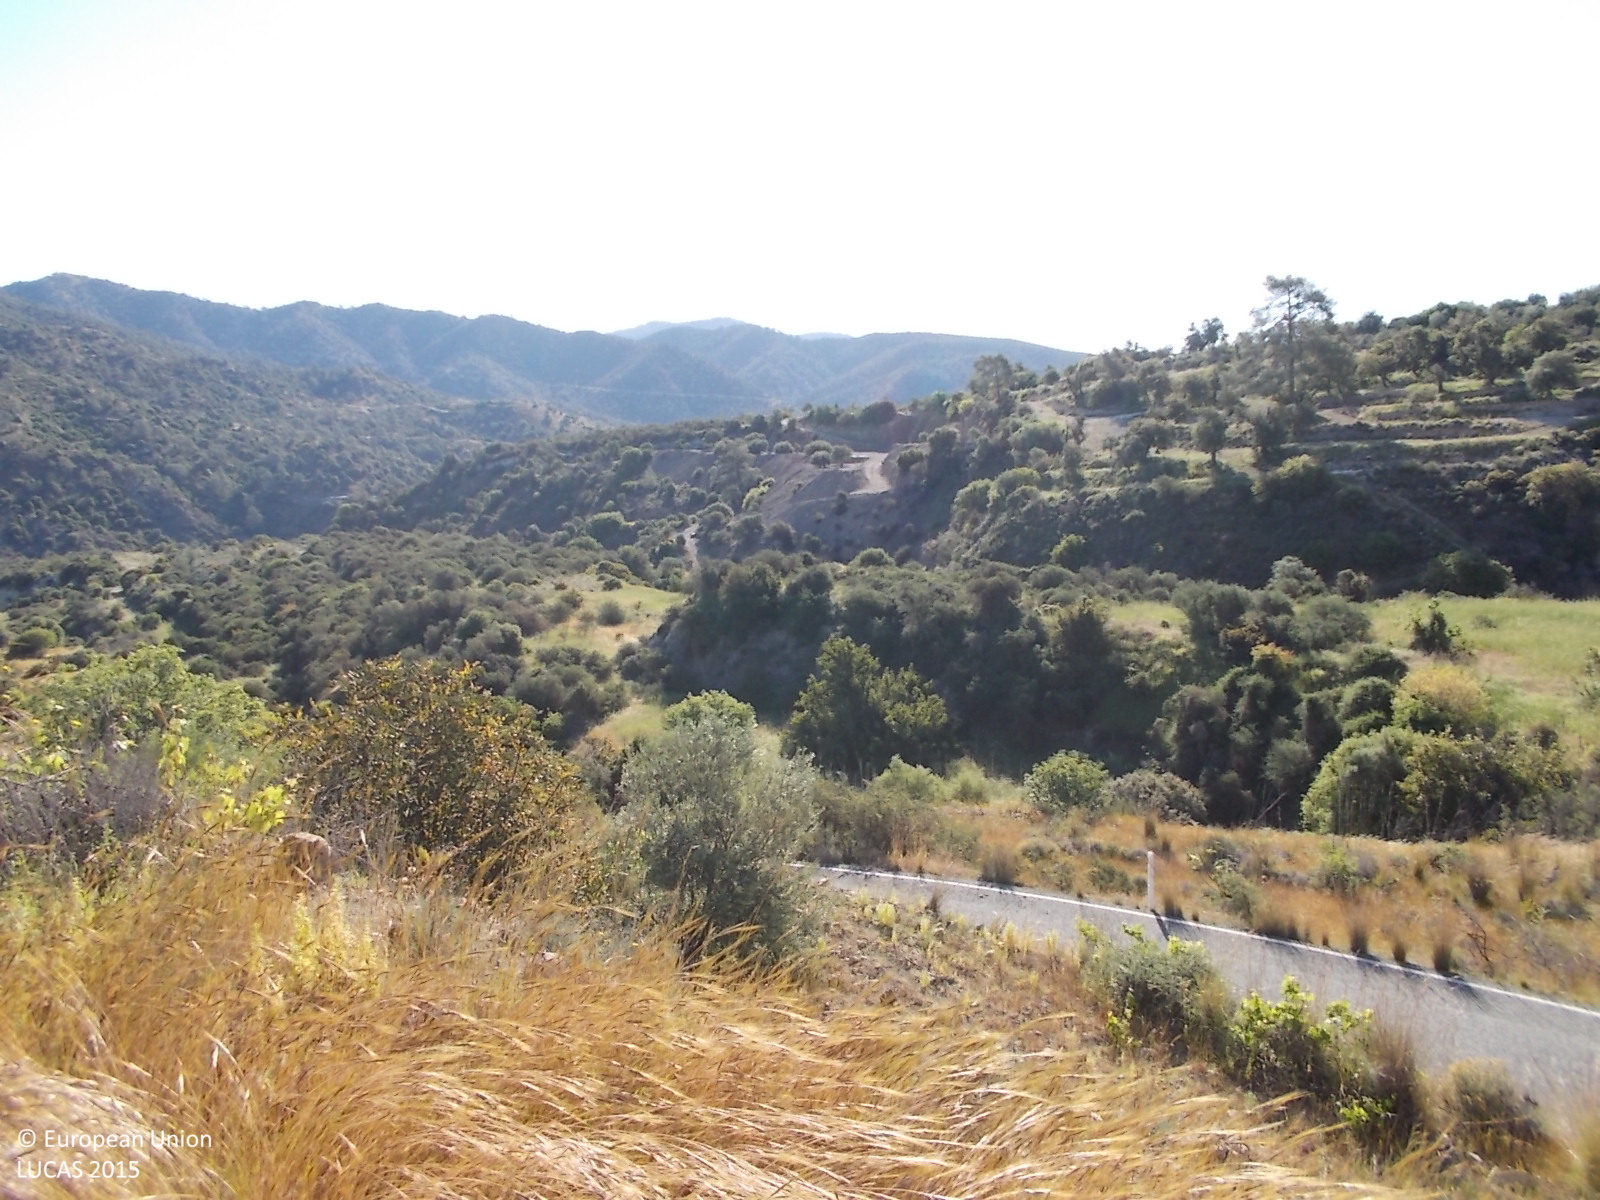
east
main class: Cropland
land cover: Olive groves
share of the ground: 25 - 50 %
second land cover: Grassland without tree/shrub cover
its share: > 75 %
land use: Abandoned areas
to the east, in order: Olive groves; Grassland without tree/shrub cover; Paved roads, cycling and walking lanes; Abandoned hedges; Shrubland with sparse tree cover; Spontaneously vegetated surfaces; Shrubland with sparse tree cover; Inland fresh running water; Shrubland with sparse tree cover; Tracks; Other bare soil; Olive groves
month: April
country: CY
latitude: 34.7782
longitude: 33.0616
